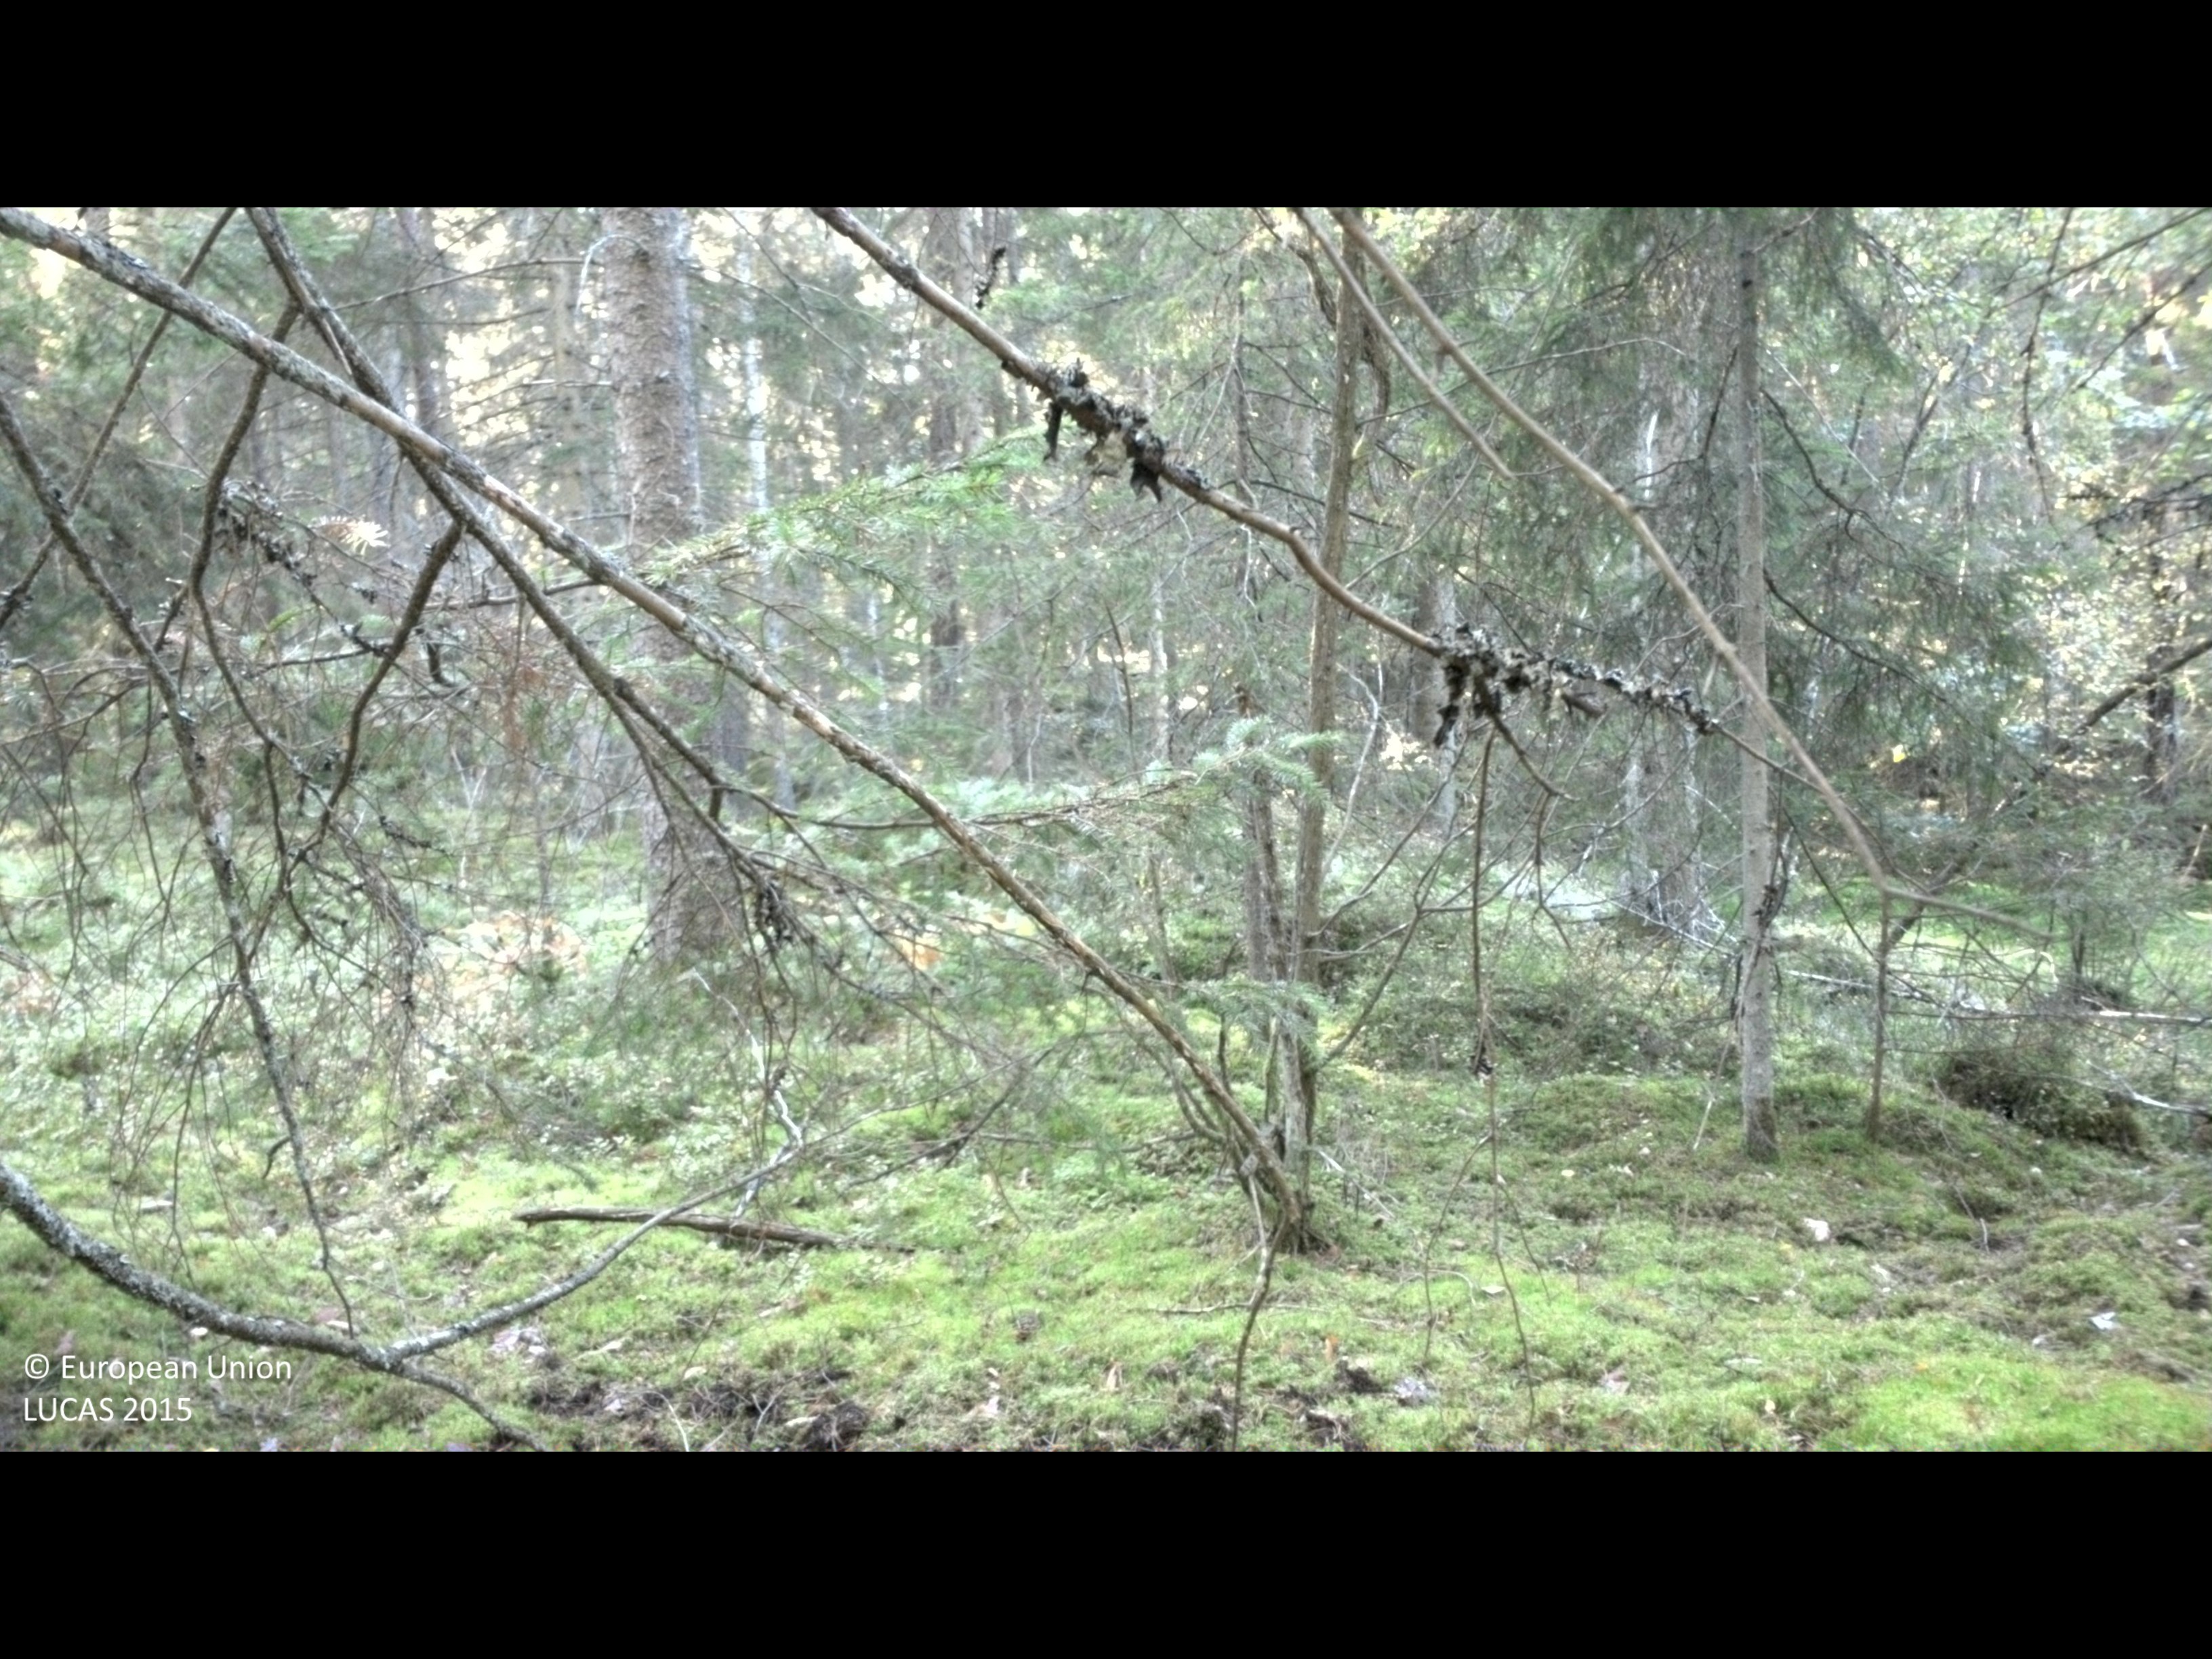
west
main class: Woodland
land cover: Spruce dominated coniferous woodland
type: boreal forest
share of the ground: > 75 %
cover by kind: coniferous forest trees 75 %, lichens and mosses 15 %, shrubs 10 %
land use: Forestry
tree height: > 5 m
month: September
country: SE
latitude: 56.3171
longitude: 15.1885
